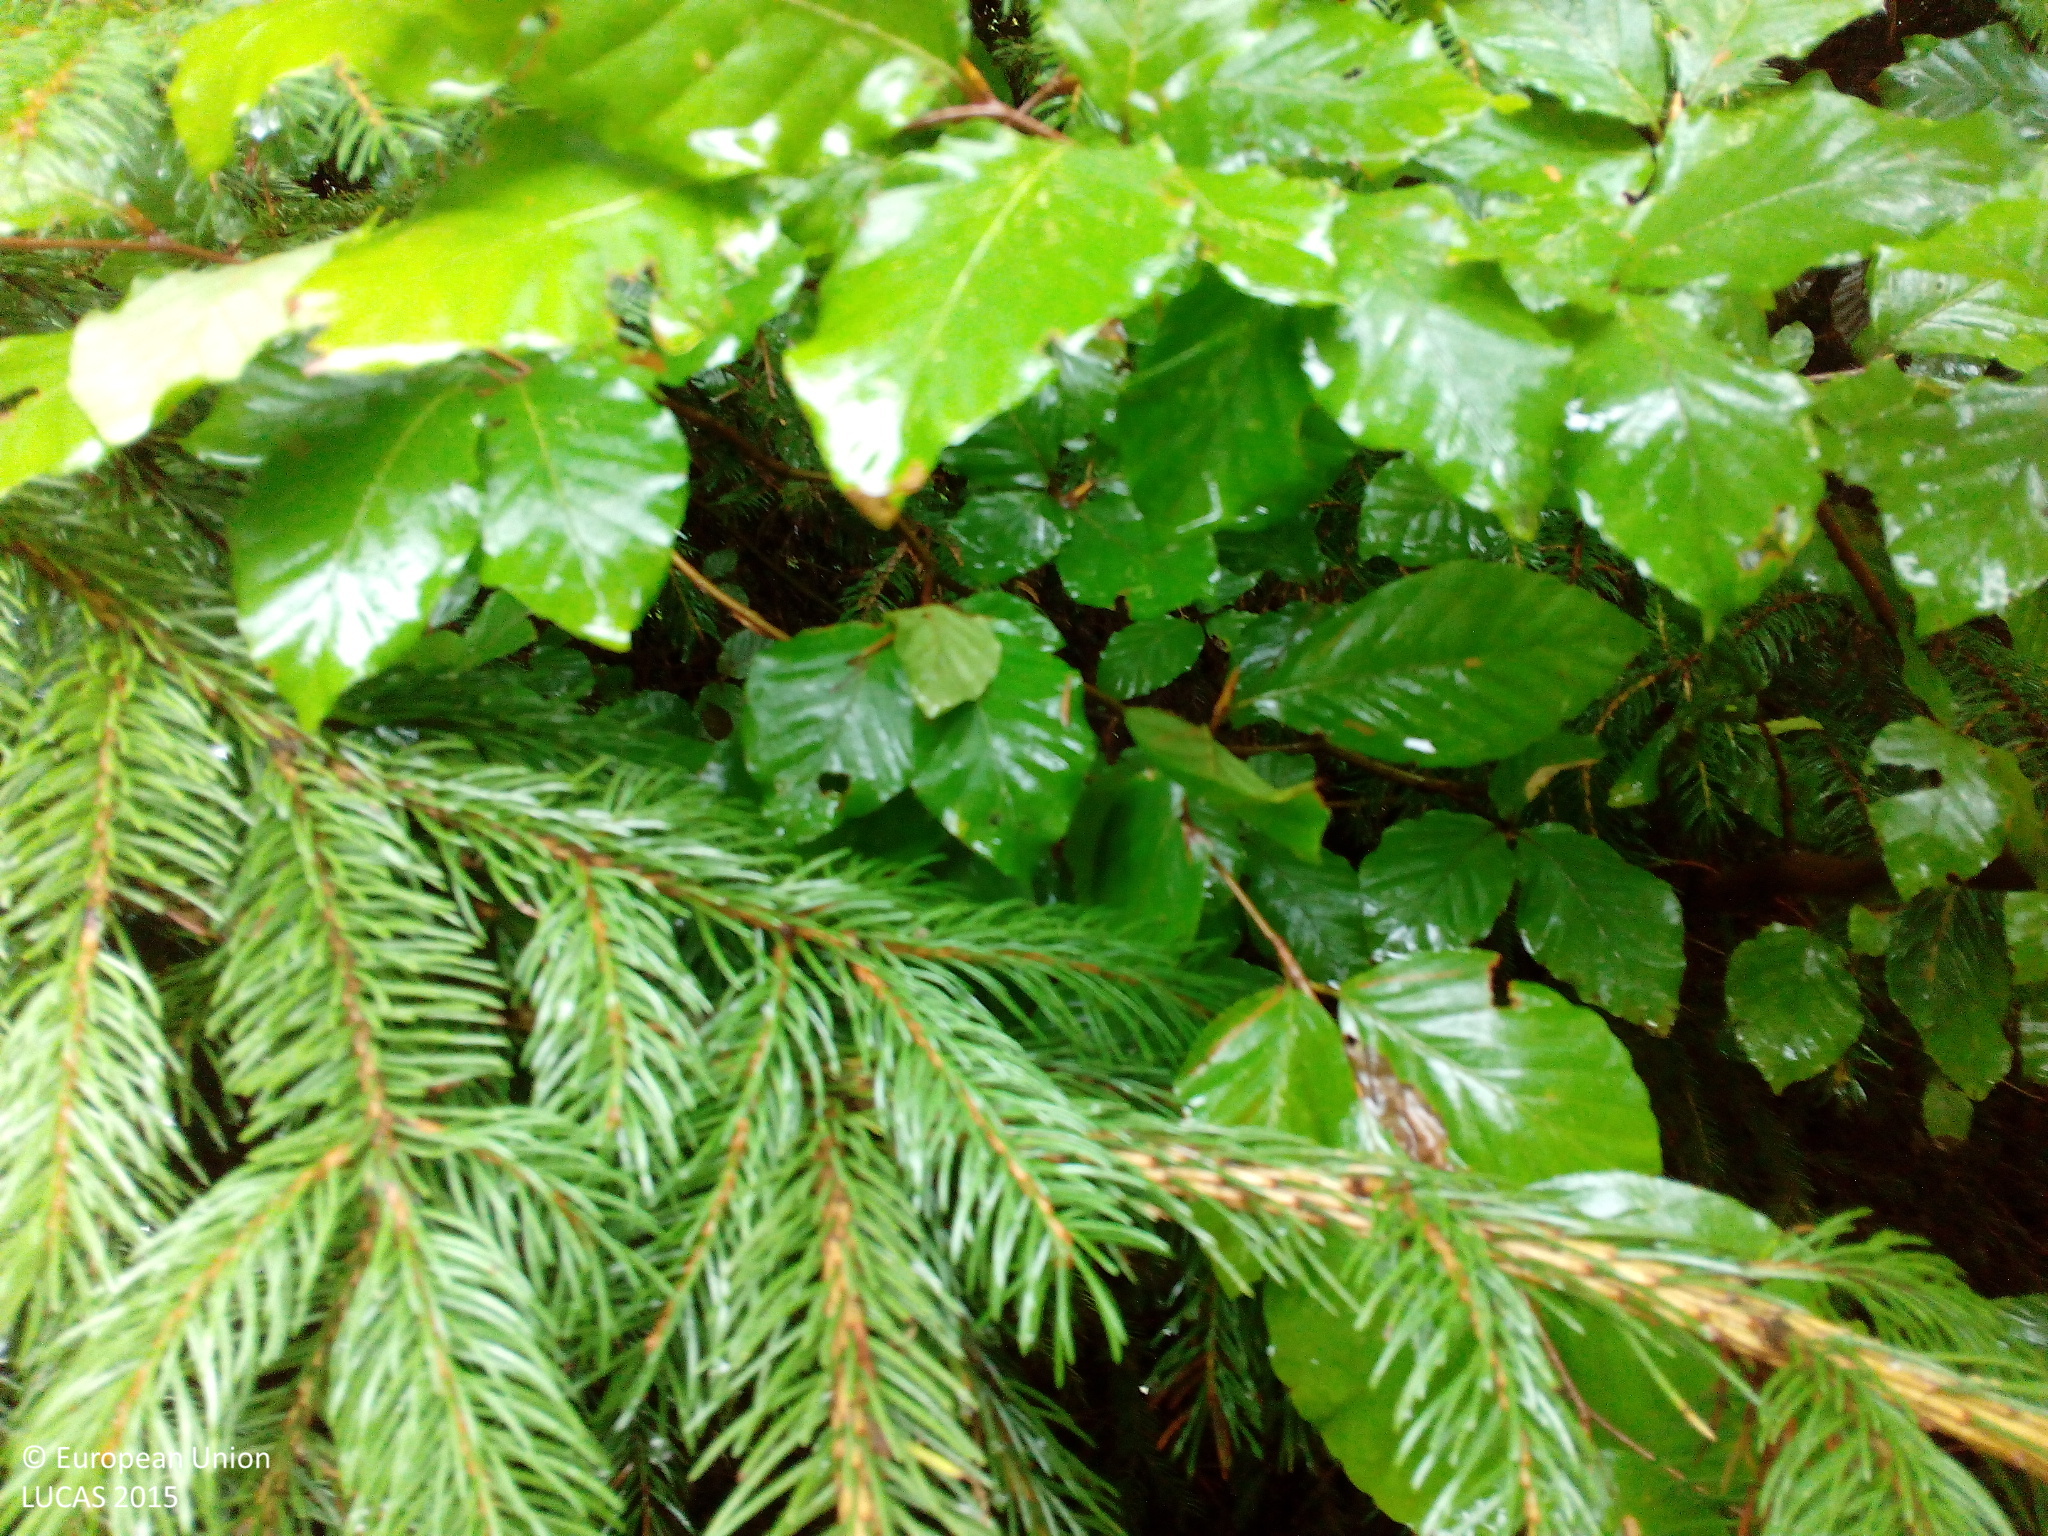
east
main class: Woodland
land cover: Spruce dominated mixed woodland
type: hemiboreal forest and nemoral coniferous forest and mixed broadleaved-coniferous forest
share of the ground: > 75 %
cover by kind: coniferous forest trees 60 %, broadleaved forest trees 40 %
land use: Forestry
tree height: < 5 m
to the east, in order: Spruce dominated mixed woodland; Broadleaved woodland; Grass margins; Tracks; Grass margins; Fences; Spruce dominated mixed woodland; Fences; Spruce dominated mixed woodland; Broadleaved woodland; Tracks; Broadleaved woodland
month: September
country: DE
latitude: 49.9318
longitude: 9.5961
